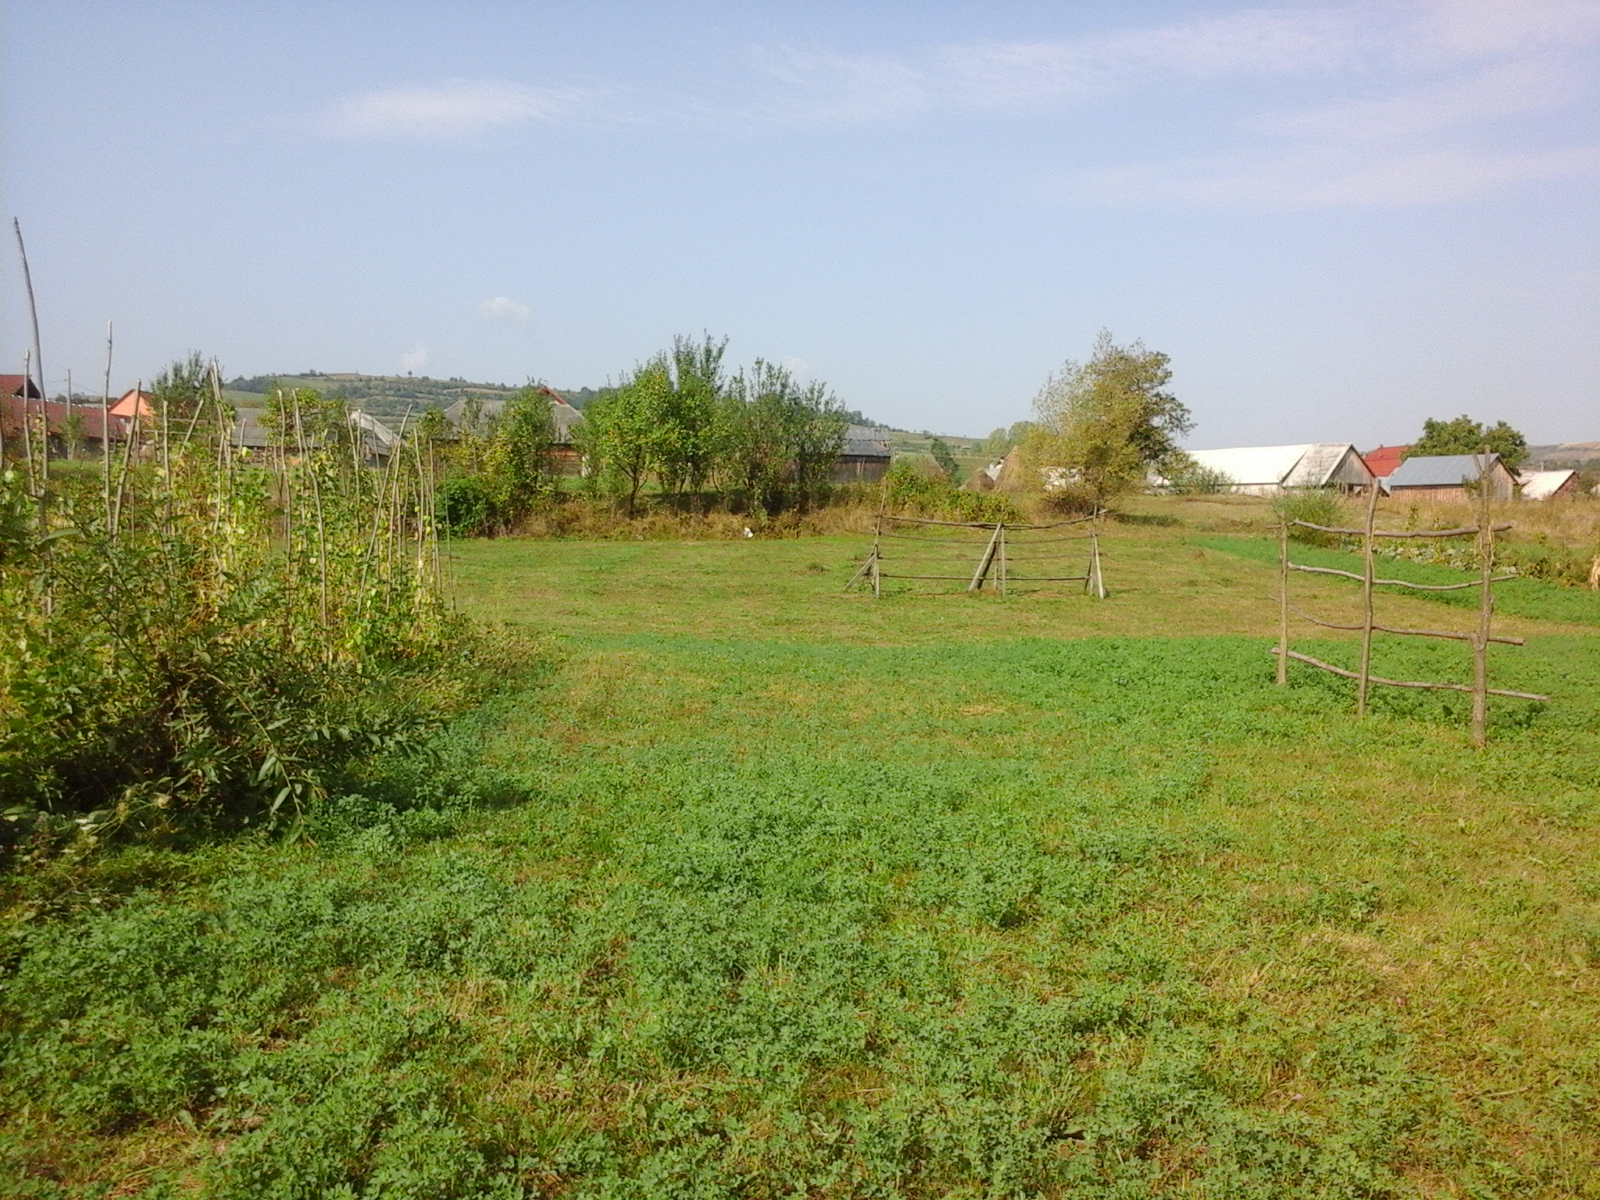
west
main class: Cropland
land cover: Lucerne
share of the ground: > 75 %
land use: Agriculture (excluding fallow land and kitchen gardens)
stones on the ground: < 10 %
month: September
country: RO
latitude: 47.7144
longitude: 24.2317
